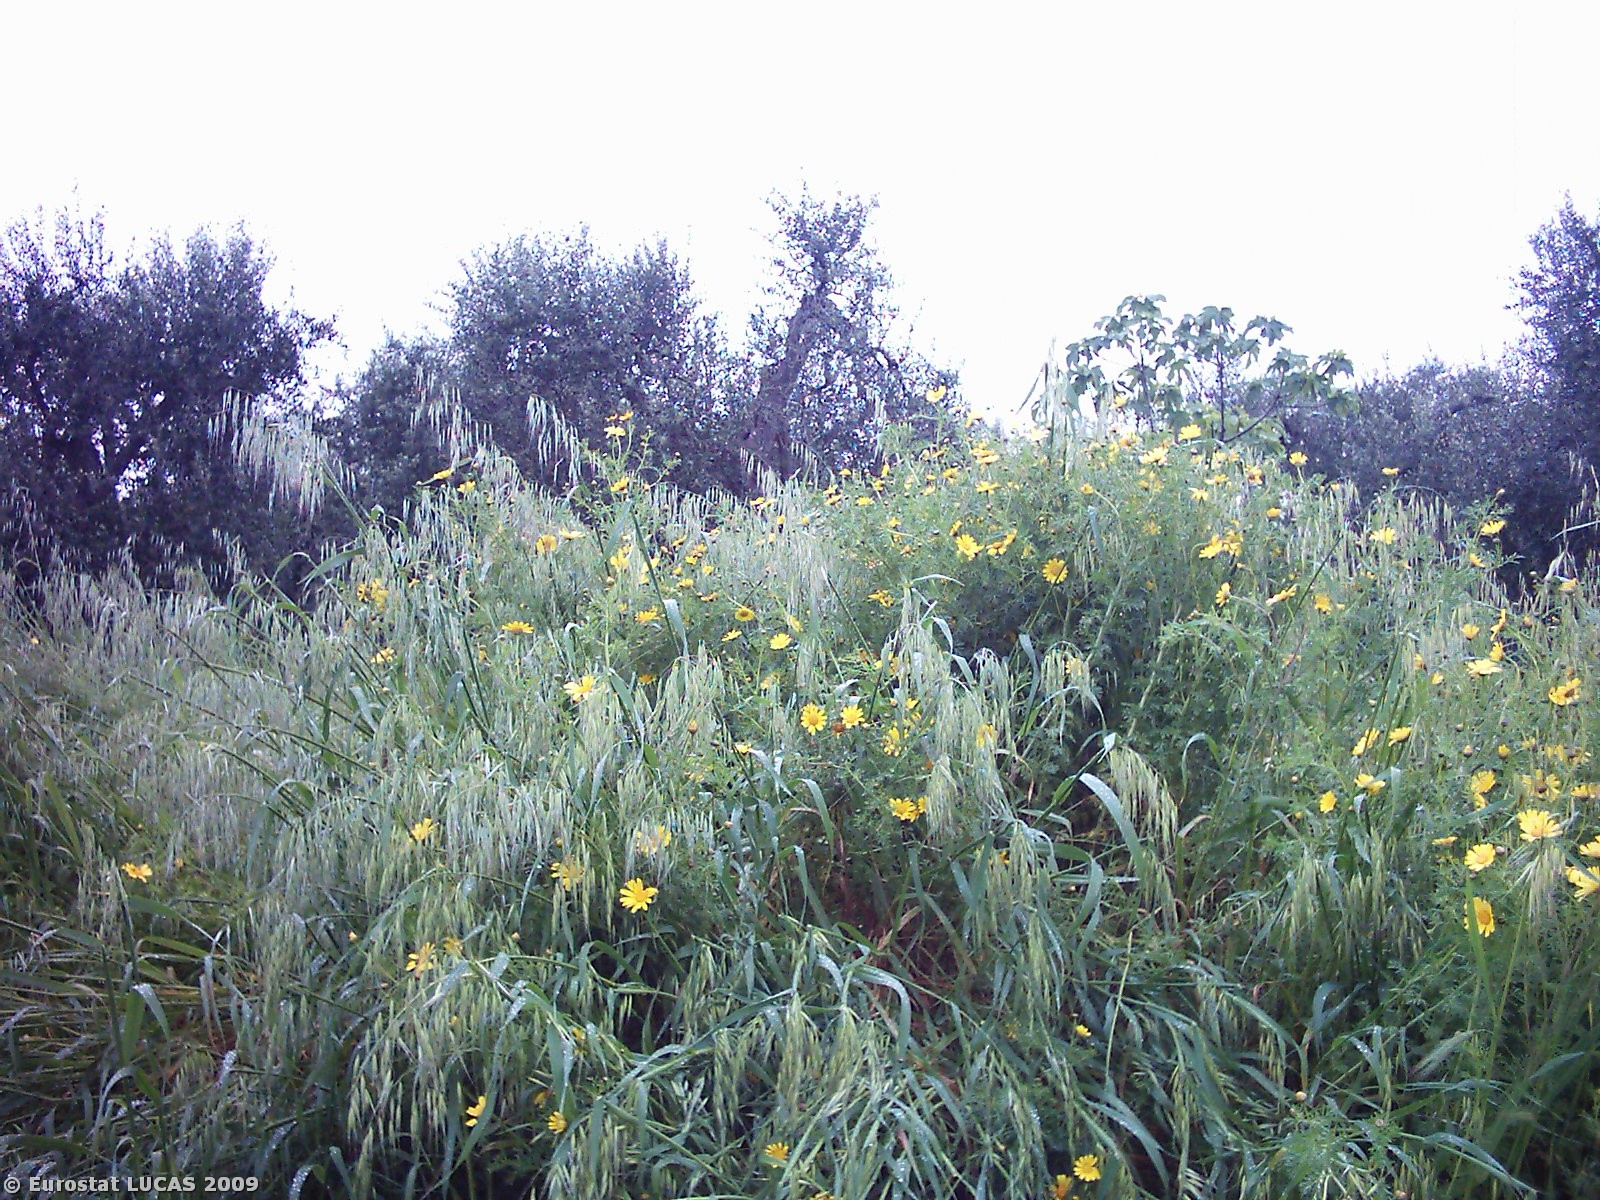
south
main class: Grassland
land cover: Spontaneously vegetated surfaces
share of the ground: > 75 %
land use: Fallow land
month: April
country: IT
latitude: 41.0903
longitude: 16.9673
